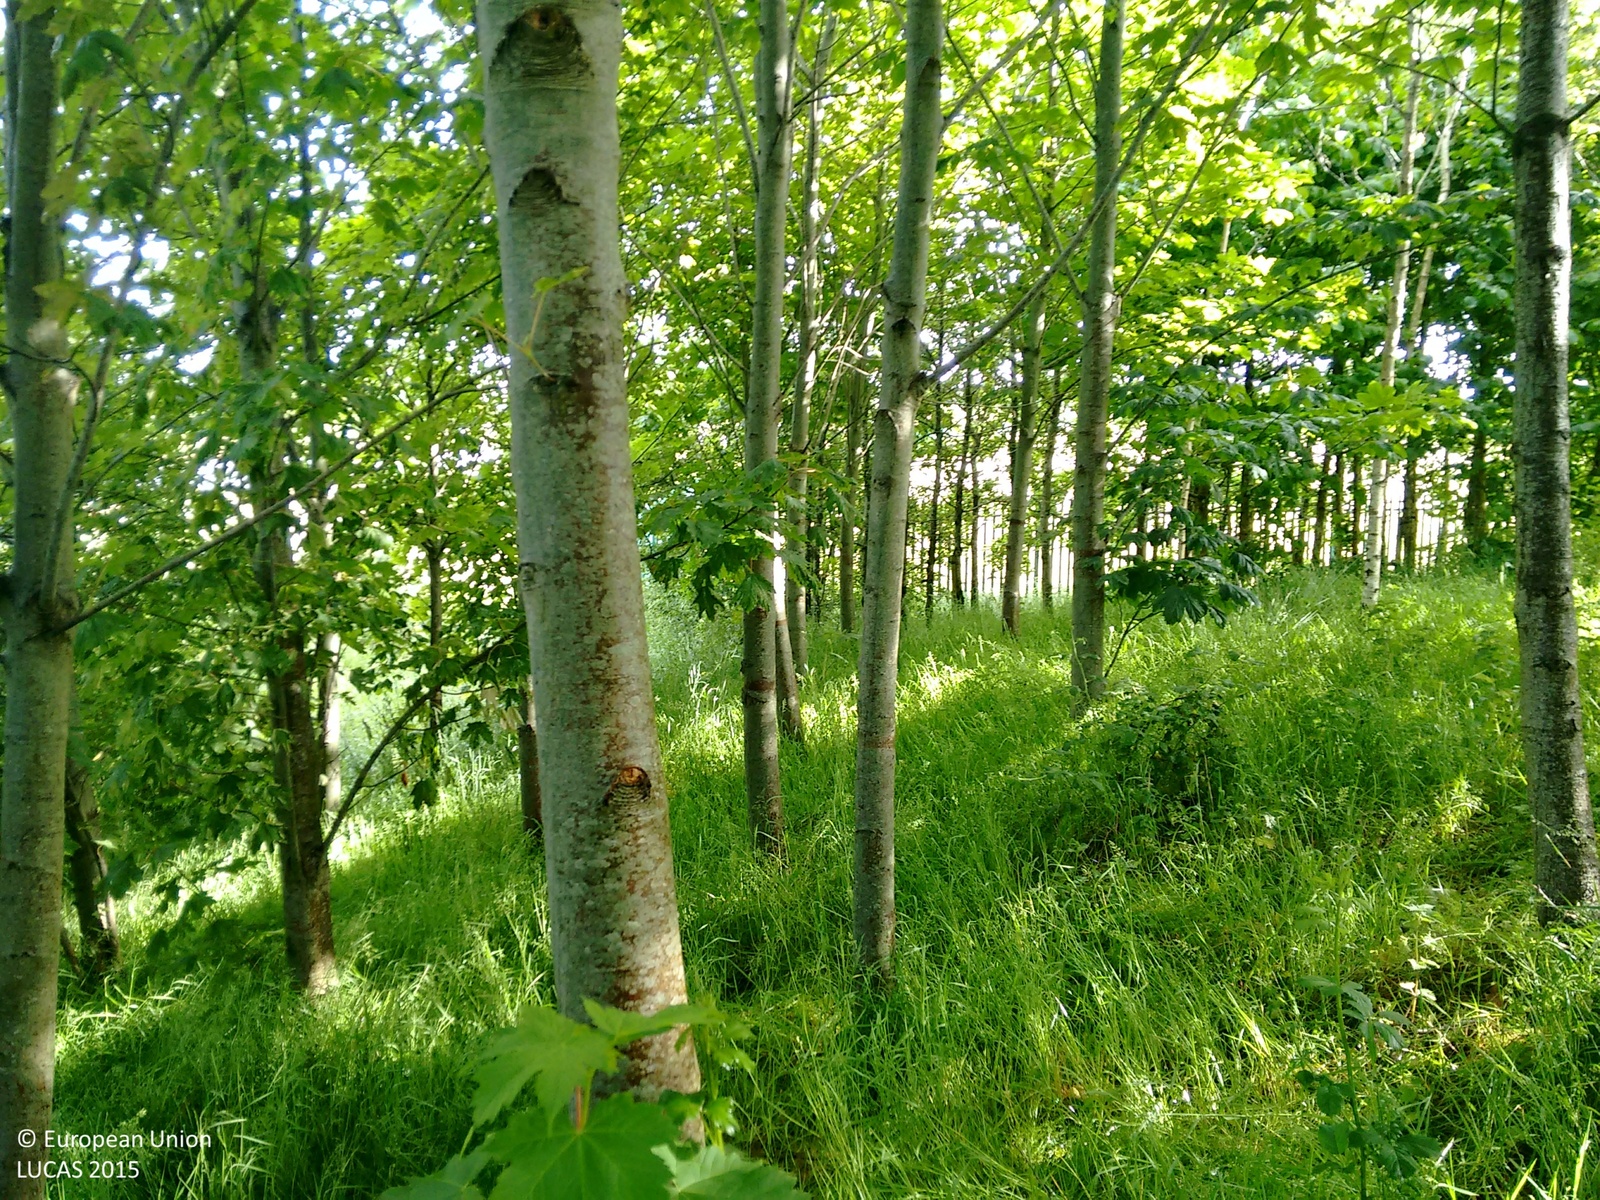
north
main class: Woodland
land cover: Broadleaved woodland
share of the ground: > 75 %
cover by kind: broadleaved forest trees 95 %, herbaceous plants 5 %
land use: Semi-natural and natural areas not in use
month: June
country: IE
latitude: 52.2558
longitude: -7.1562
